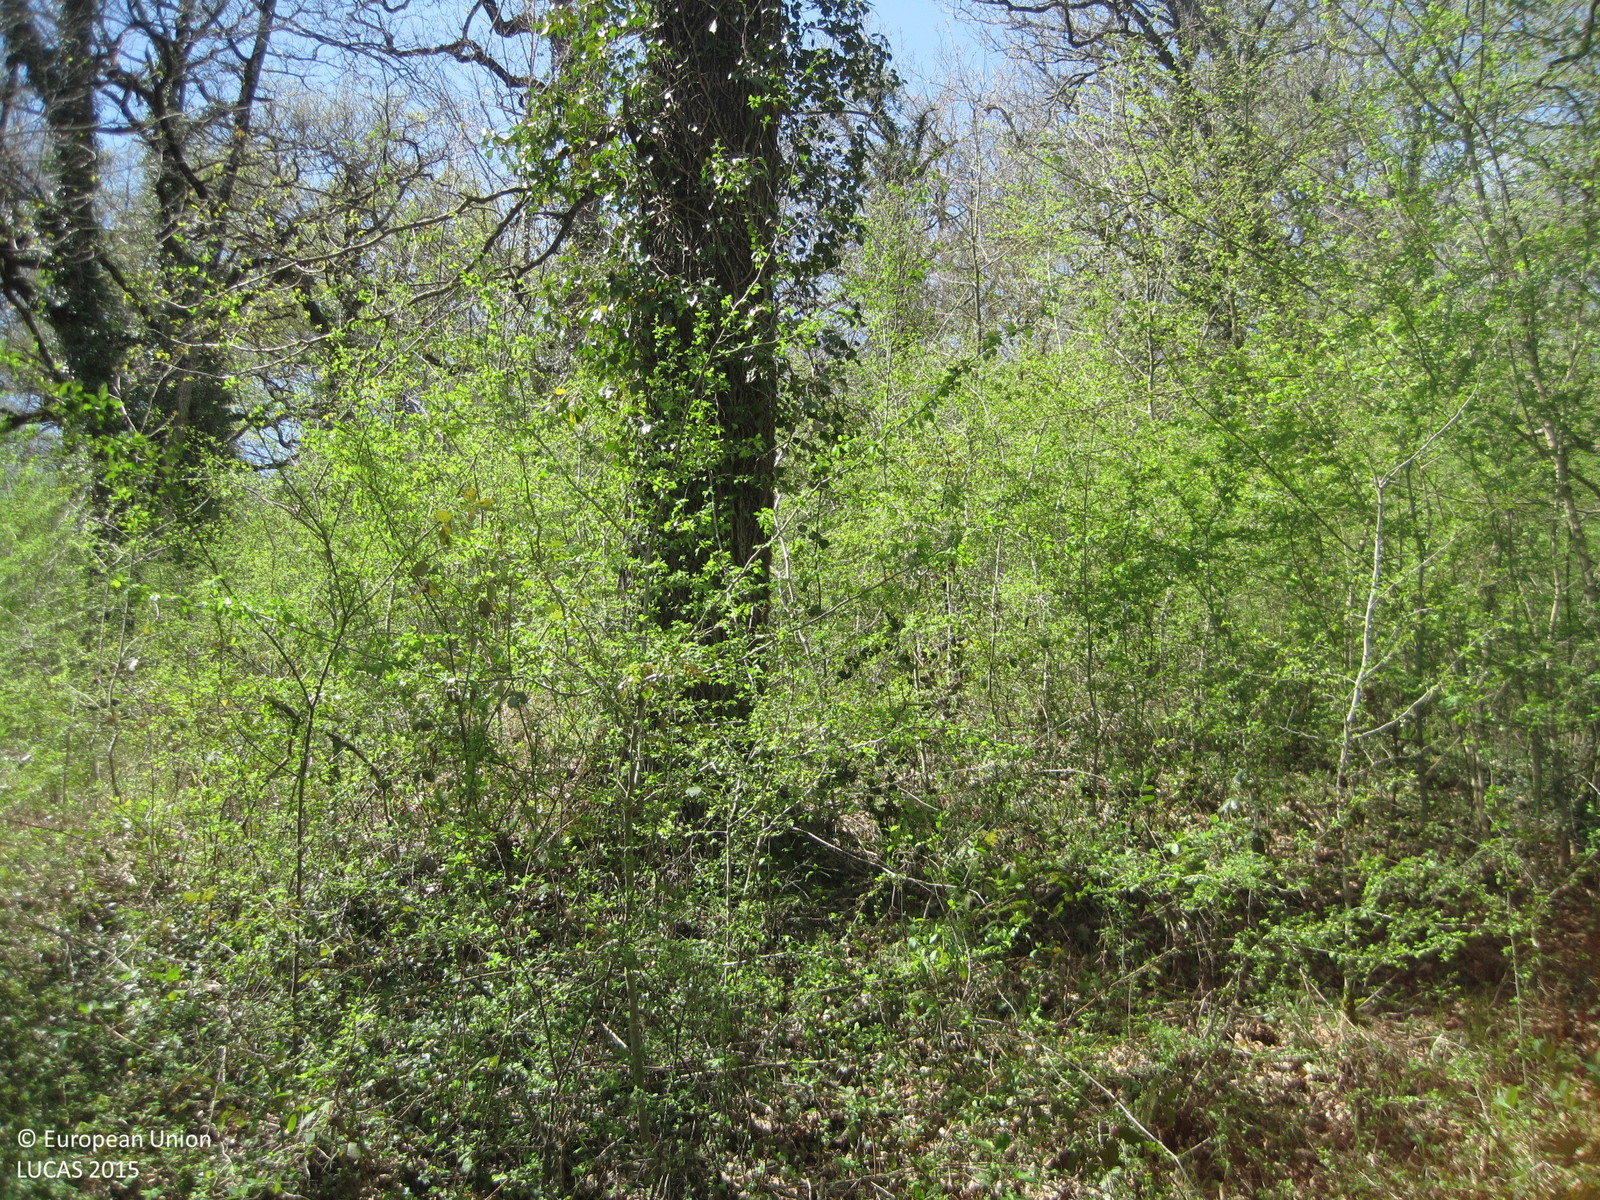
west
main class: Woodland
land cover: Broadleaved woodland
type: acidophilous oak and oak-birch forest
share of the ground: > 75 %
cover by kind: broadleaved forest trees 100 %
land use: Forestry
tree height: > 5 m
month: April
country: ES
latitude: 42.8770
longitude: -2.2272
